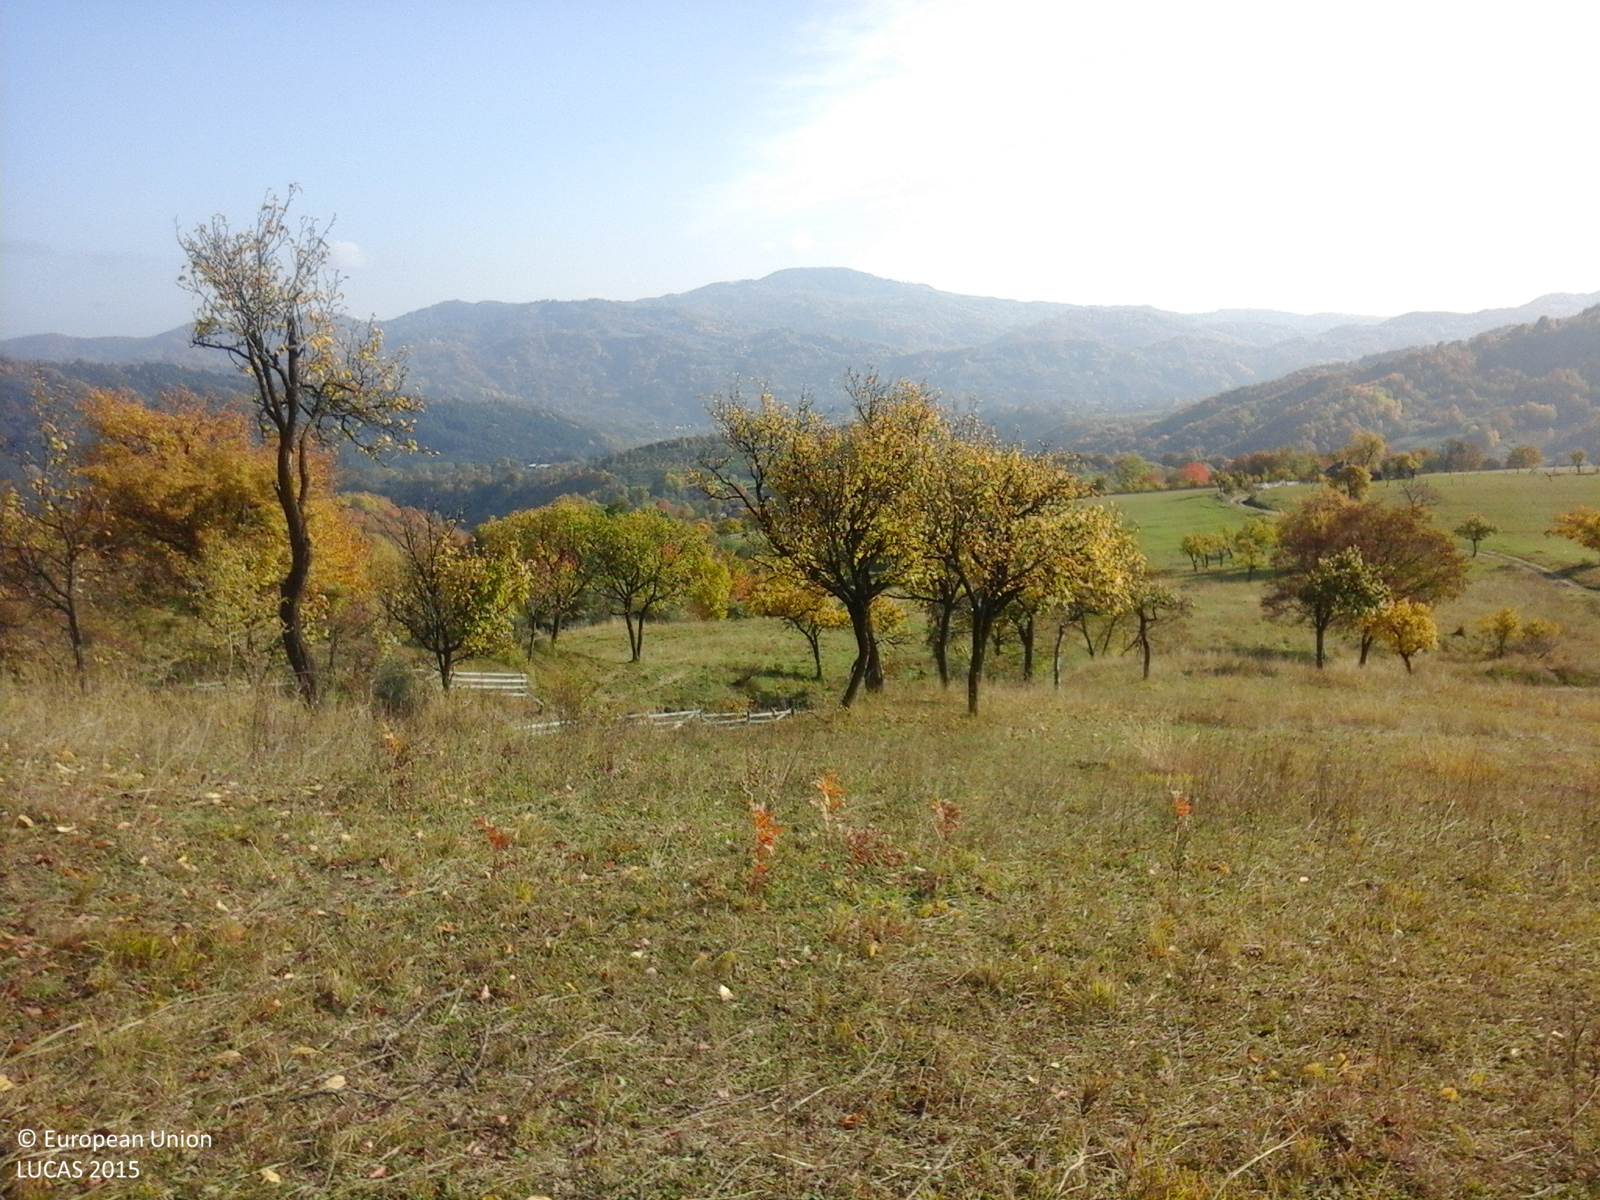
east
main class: Cropland
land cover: Other fruit trees and berries
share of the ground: > 75 %
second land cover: Grassland without tree/shrub cover
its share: > 75 %
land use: Agriculture (excluding fallow land and kitchen gardens)
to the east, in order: Other fruit trees and berries; Grassland without tree/shrub cover; Tracks; Grassland with sparse tree/shrub cover; Grassland without tree/shrub cover; Grassland with sparse tree/shrub cover; Grassland without tree/shrub cover
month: October
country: RO
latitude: 45.8130
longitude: 26.7227
